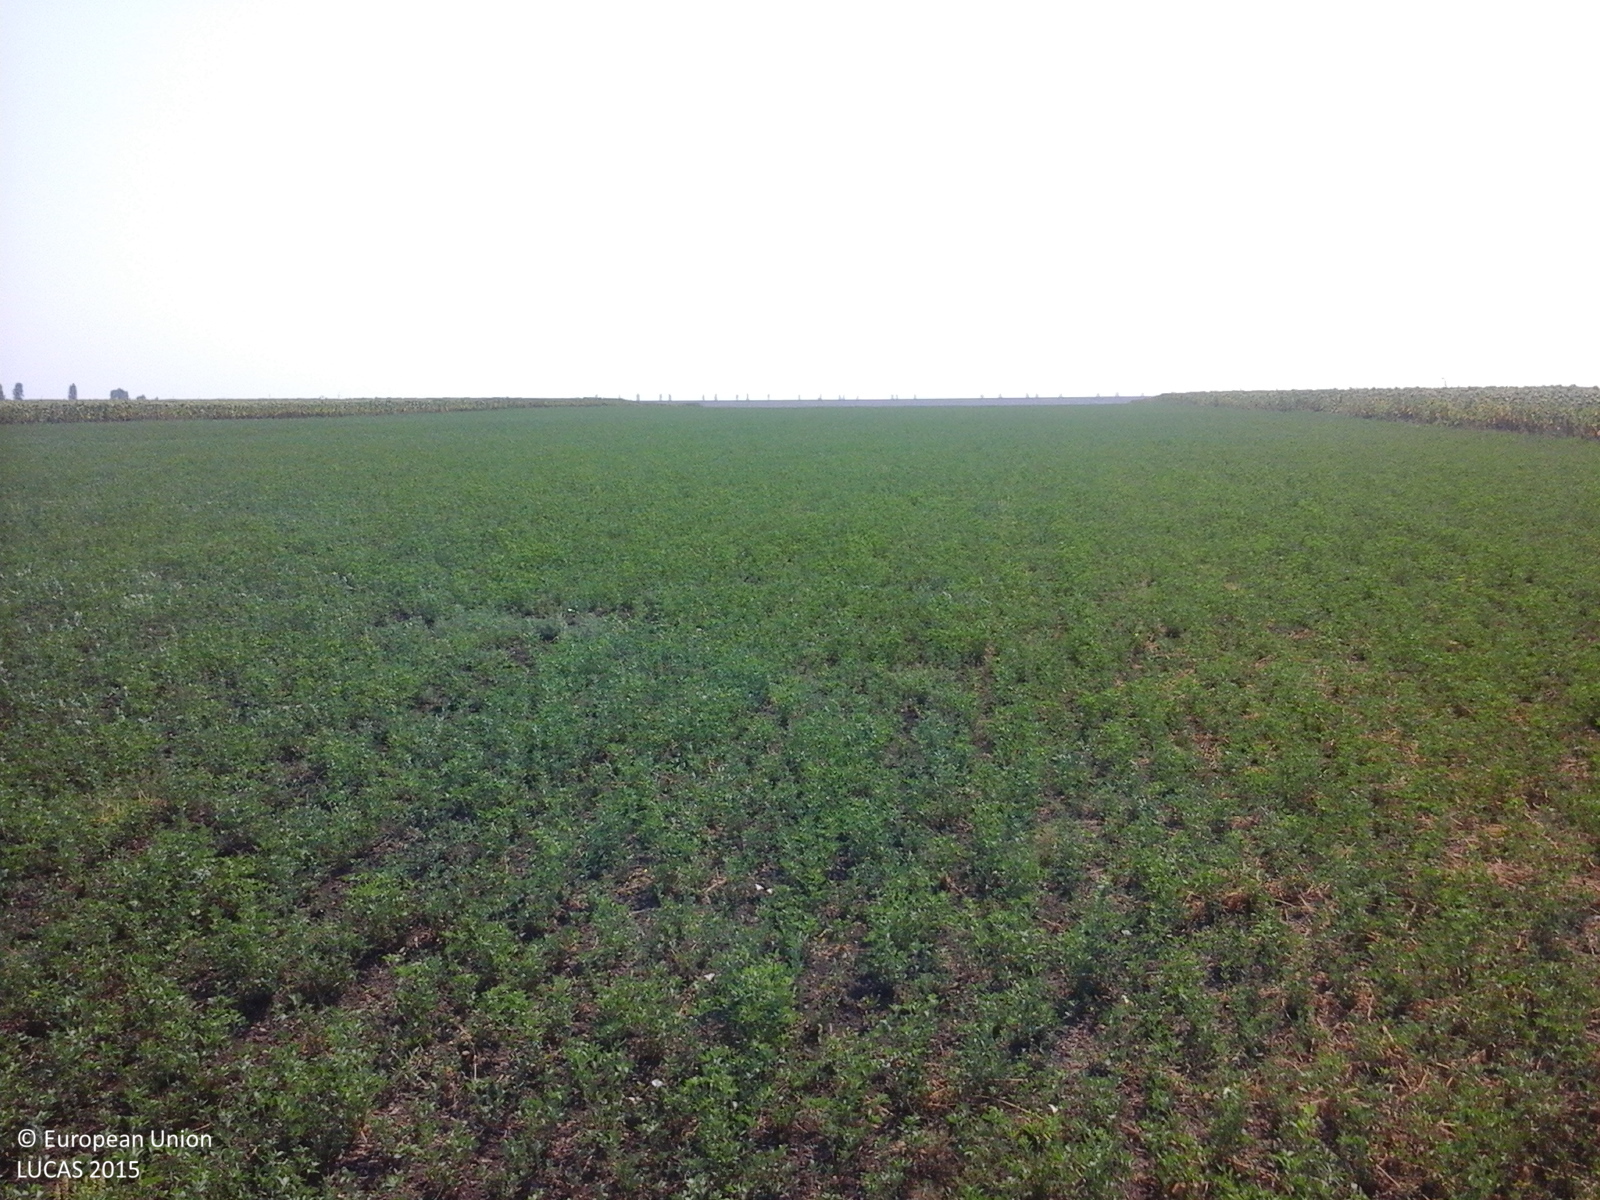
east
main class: Cropland
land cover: Lucerne
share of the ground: > 75 %
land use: Agriculture (excluding fallow land and kitchen gardens)
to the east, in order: Lucerne
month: July
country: RO
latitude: 45.7173
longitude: 27.8571
